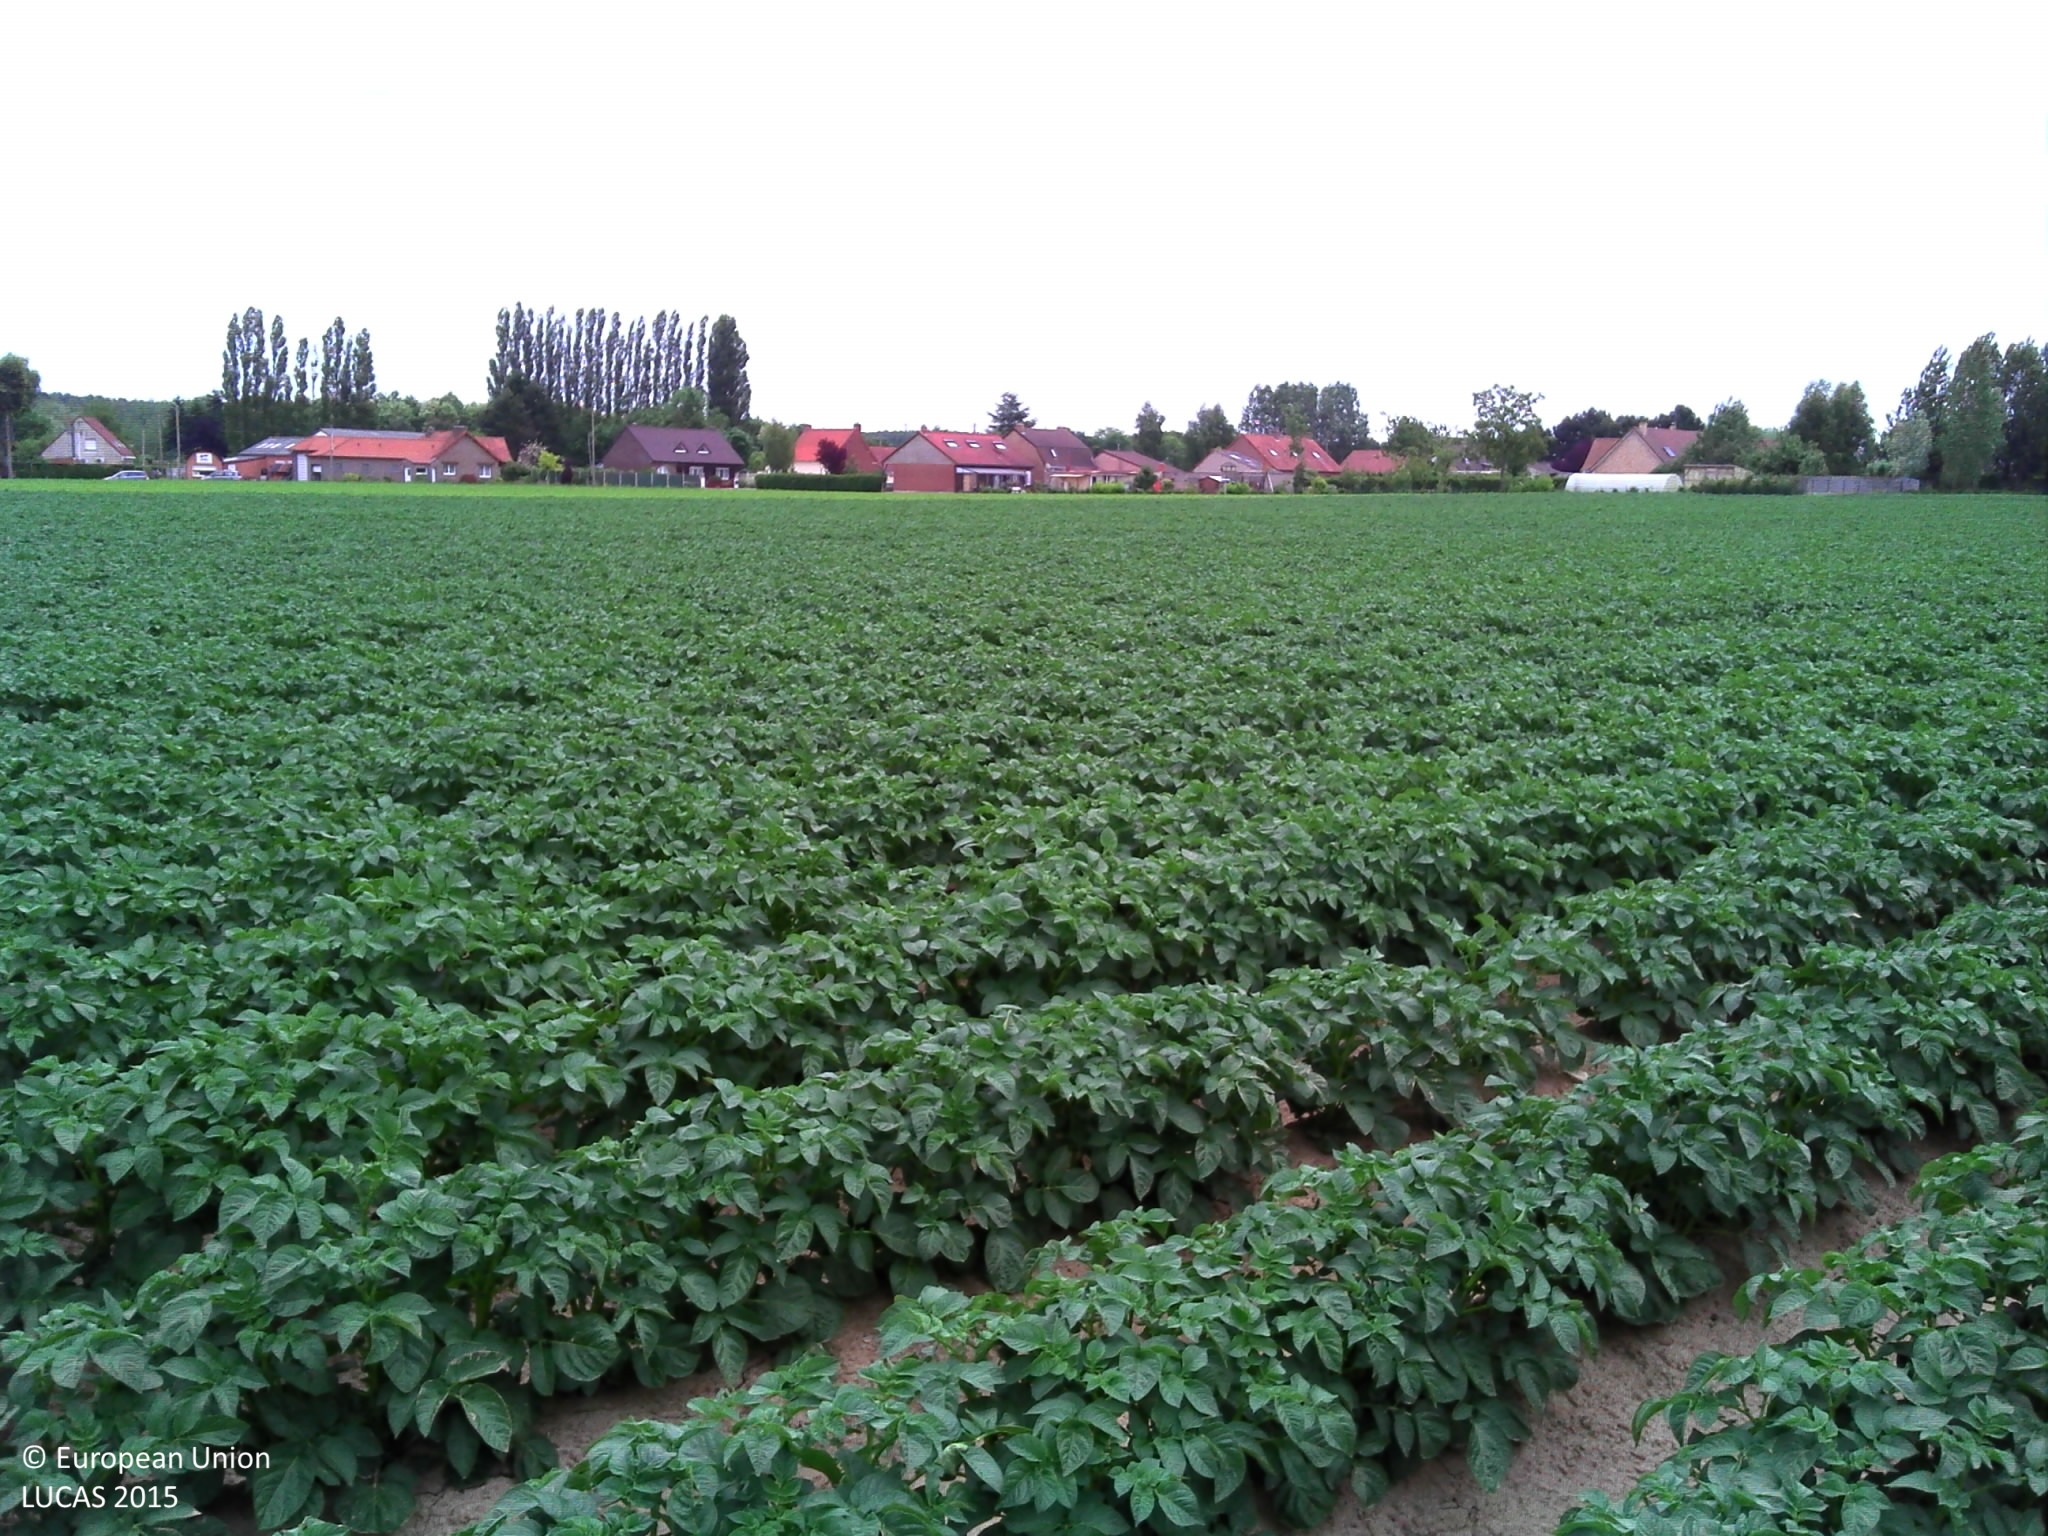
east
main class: Cropland
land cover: Potatoes
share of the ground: > 75 %
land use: Agriculture (excluding fallow land and kitchen gardens)
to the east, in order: Potatoes; Maize; Electric lines; Ditches and canals; Artificial constructions in urban areas
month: June
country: FR
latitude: 50.6843
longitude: 2.3292
